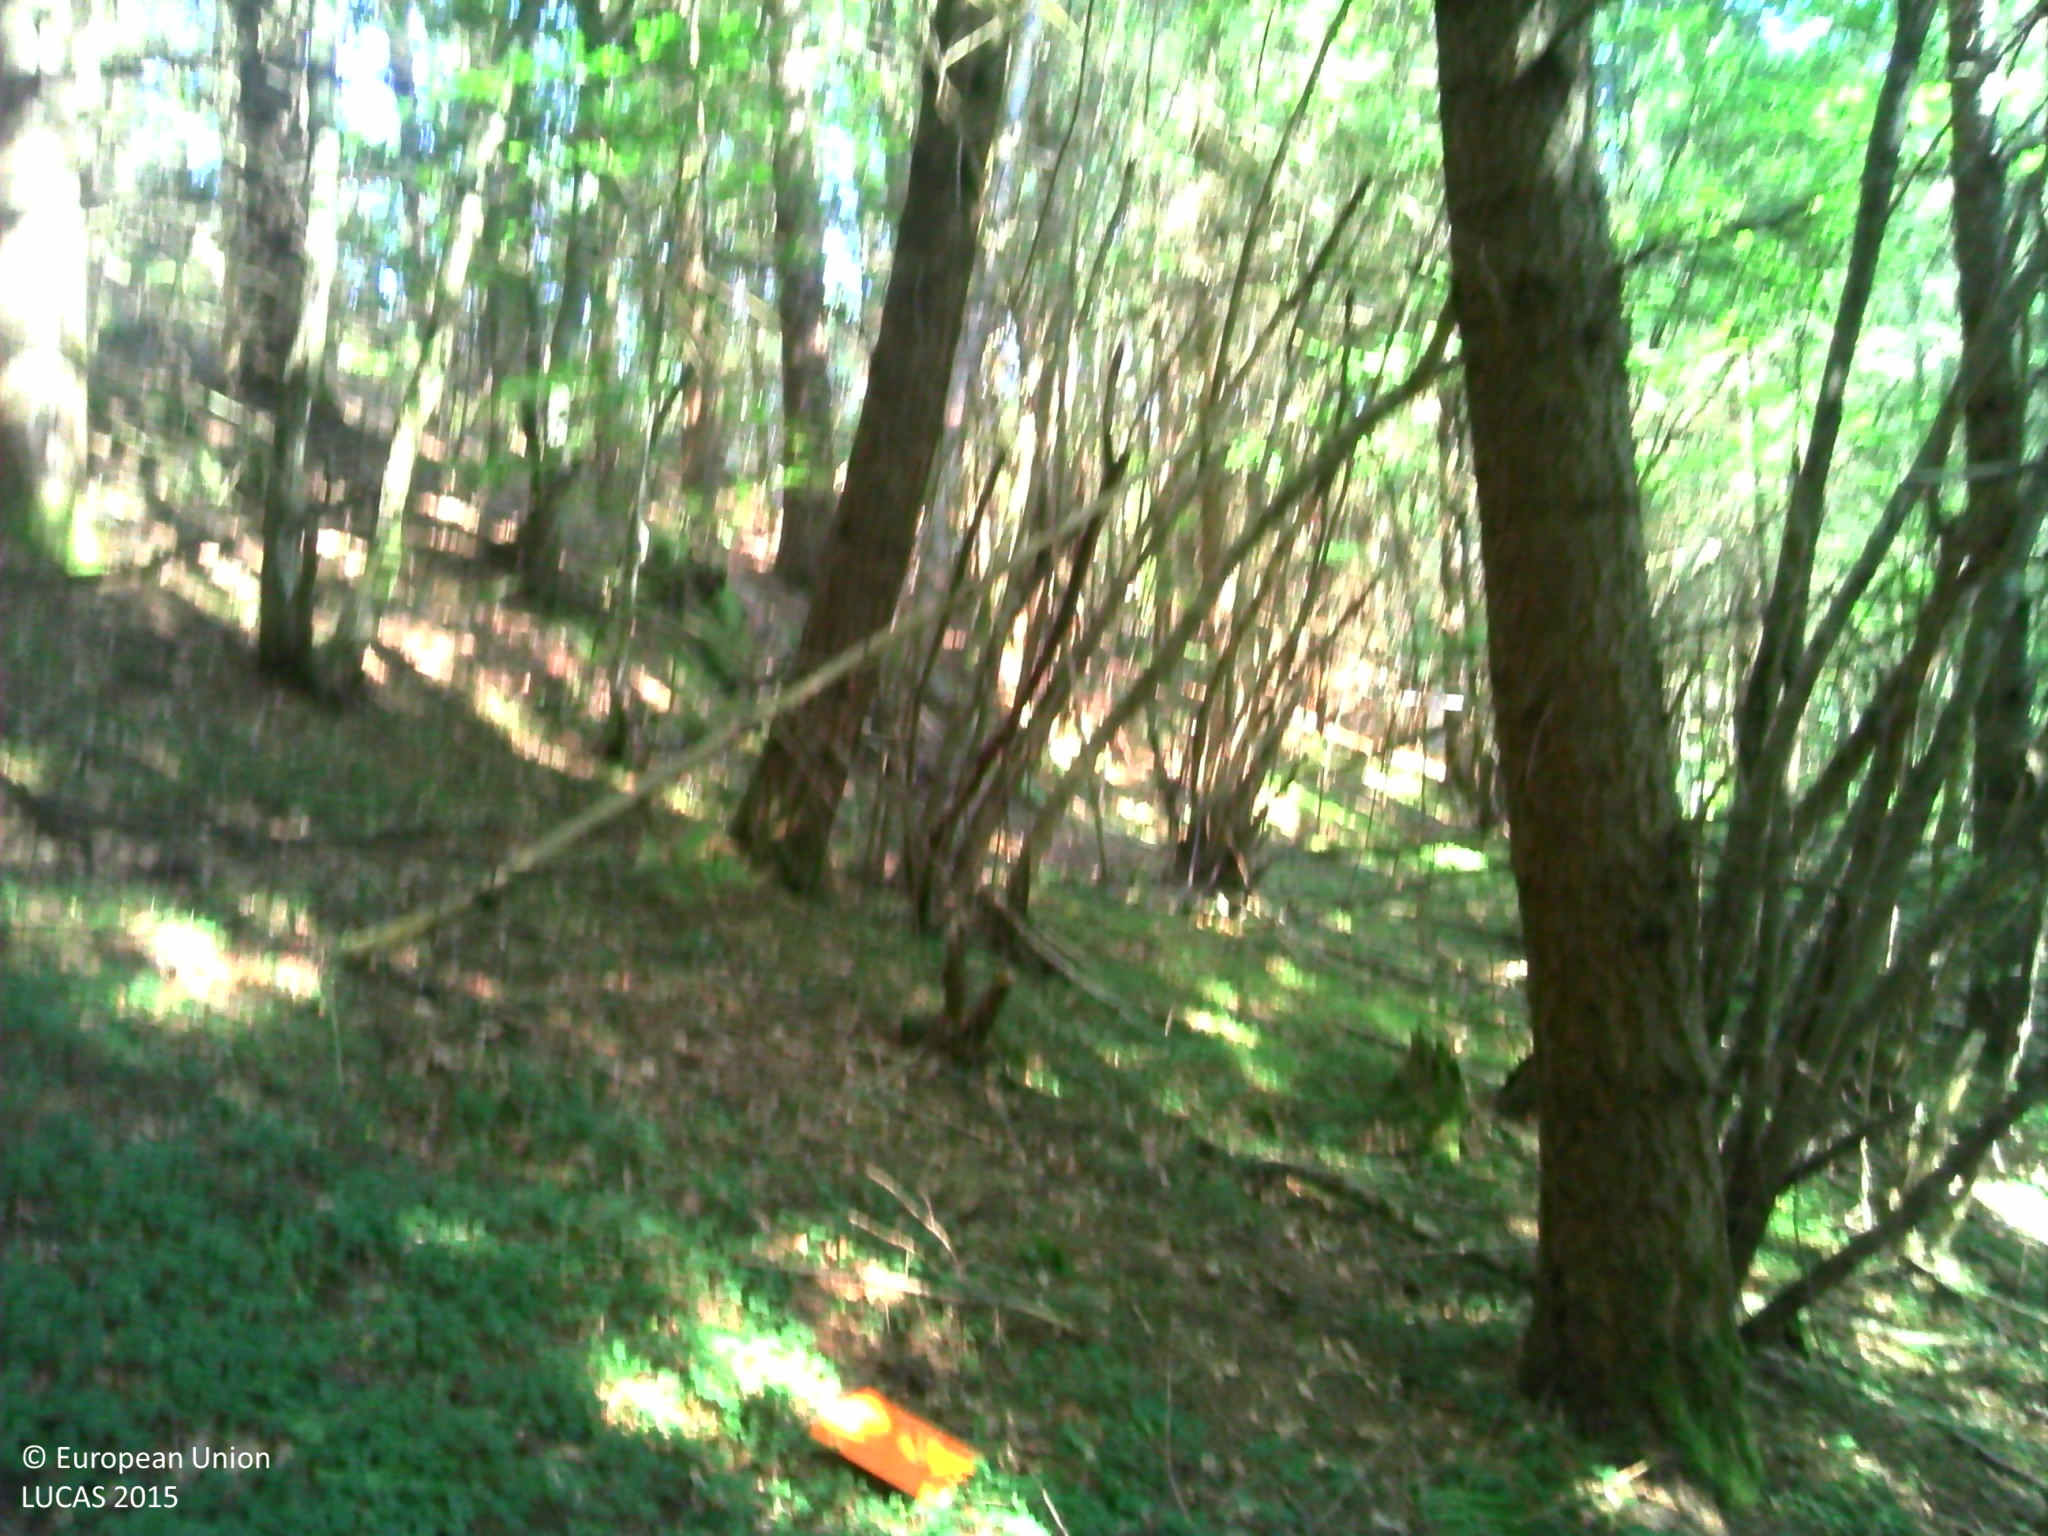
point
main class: Woodland
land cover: Pine dominated mixed woodland
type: beech forest
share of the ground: > 75 %
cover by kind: coniferous forest trees 60 %, broadleaved forest trees 20 %, shrubs 20 %
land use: Forestry
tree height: > 5 m
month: August
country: FR
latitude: 45.2527
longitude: 3.8490
